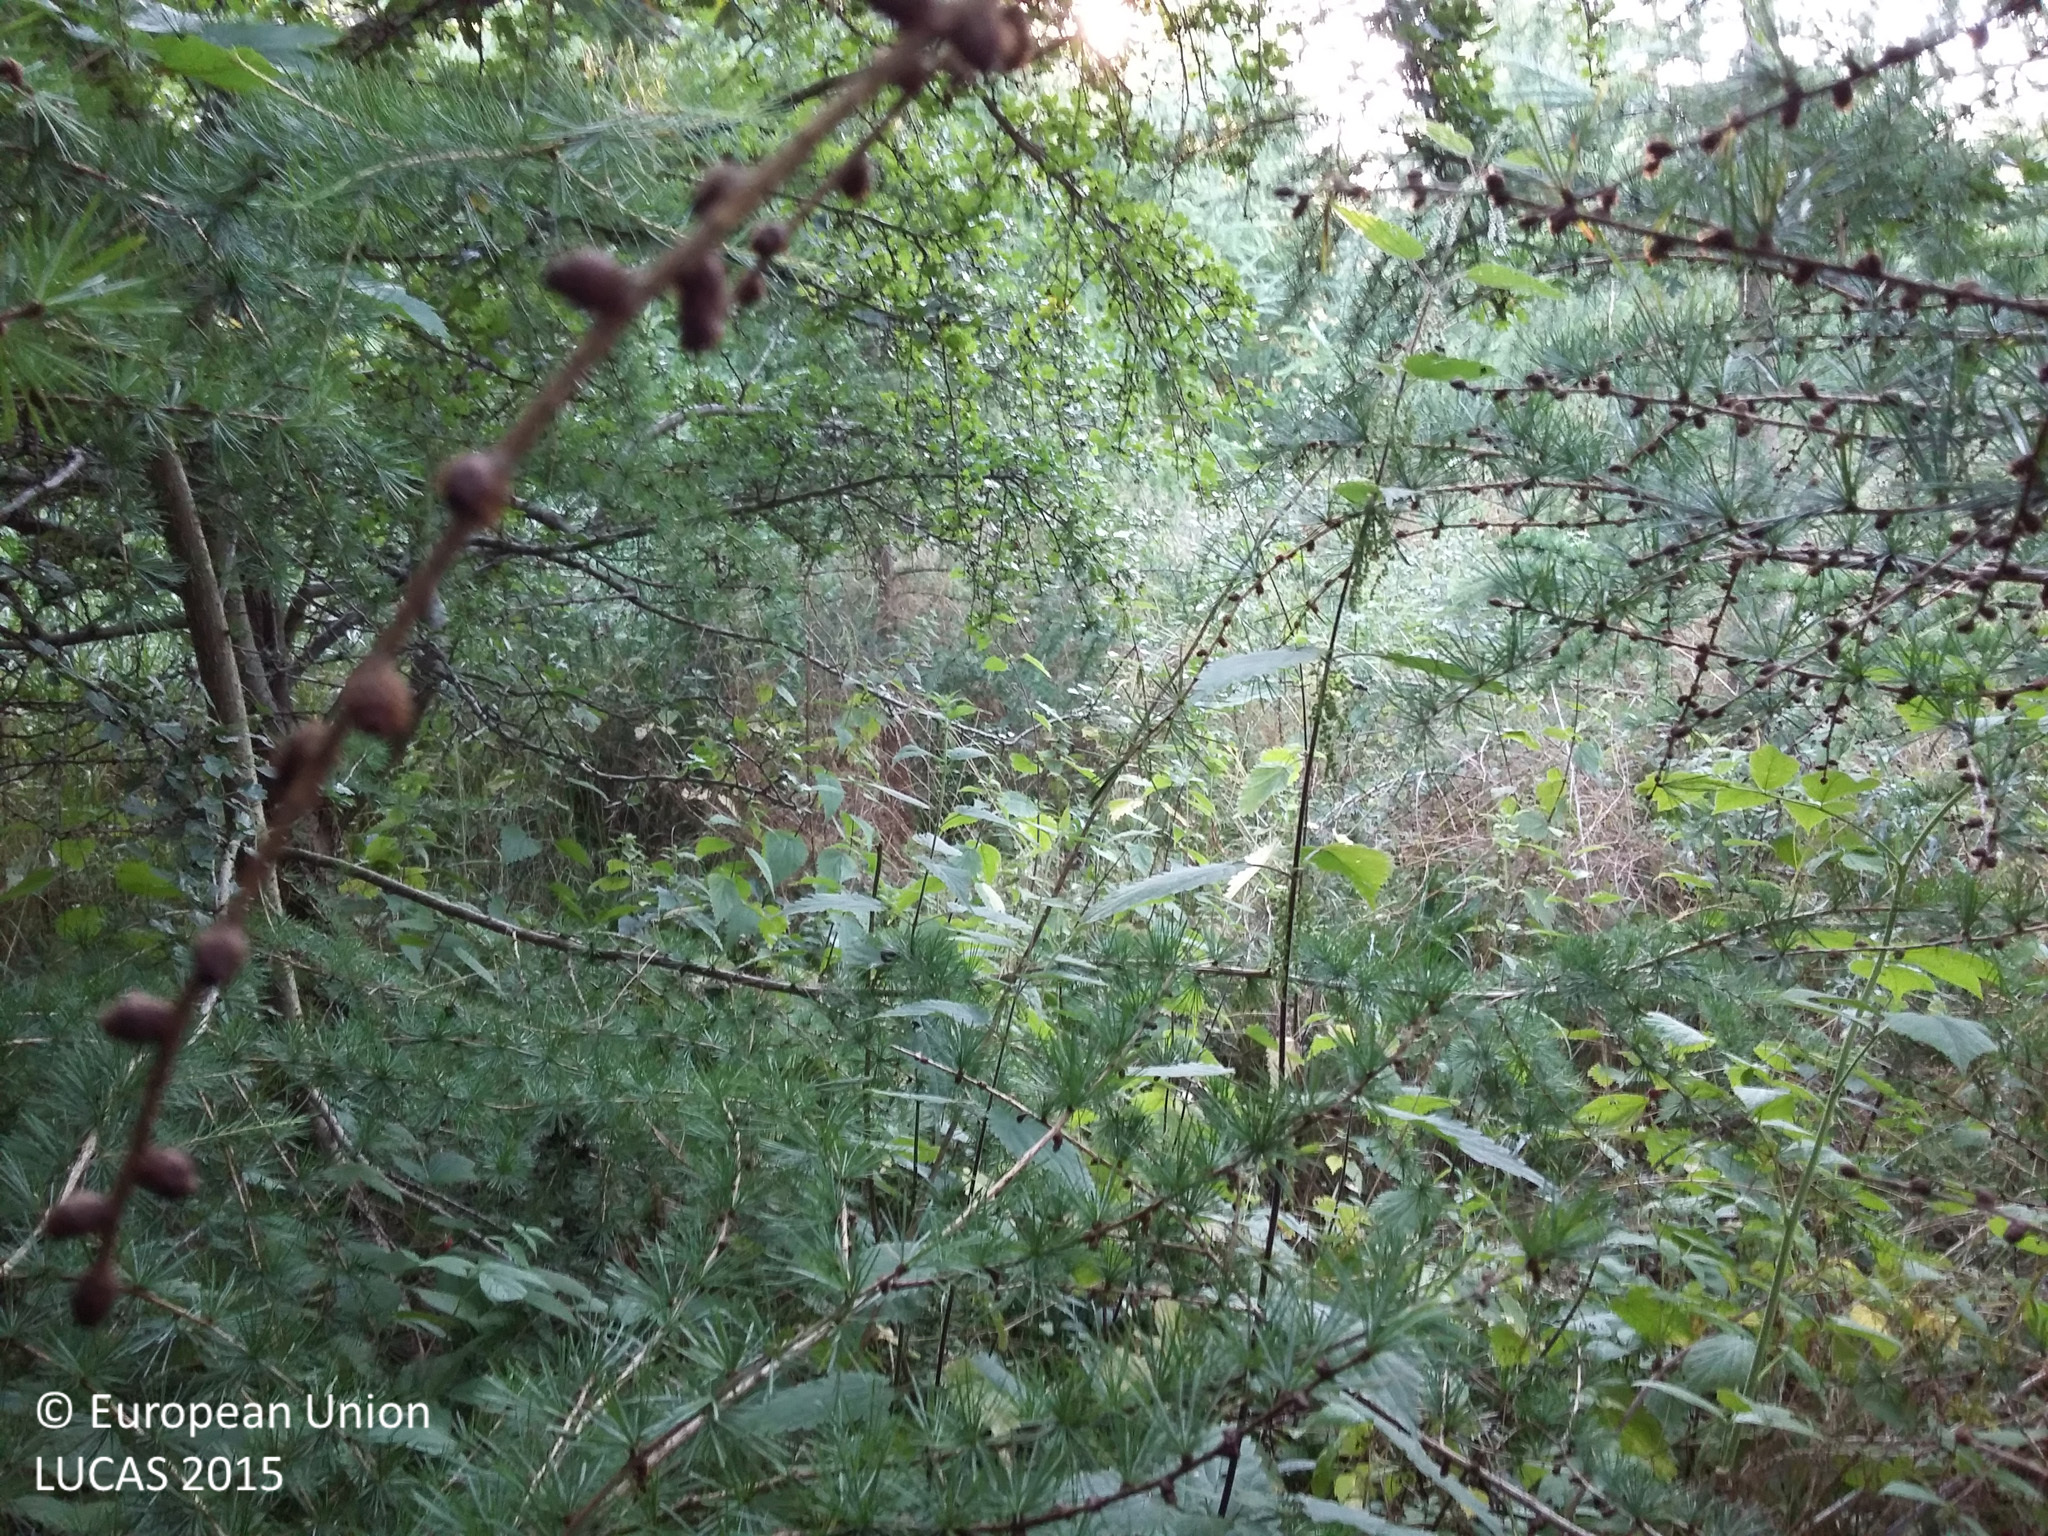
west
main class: Woodland
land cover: Other mixed woodland
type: beech forest
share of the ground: > 75 %
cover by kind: coniferous forest trees 50 %, broadleaved forest trees 40 %, shrubs 5 %, herbaceous plants 5 %
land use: Forestry
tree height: > 5 m
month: August
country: DK
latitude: 55.3625
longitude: 12.0335
